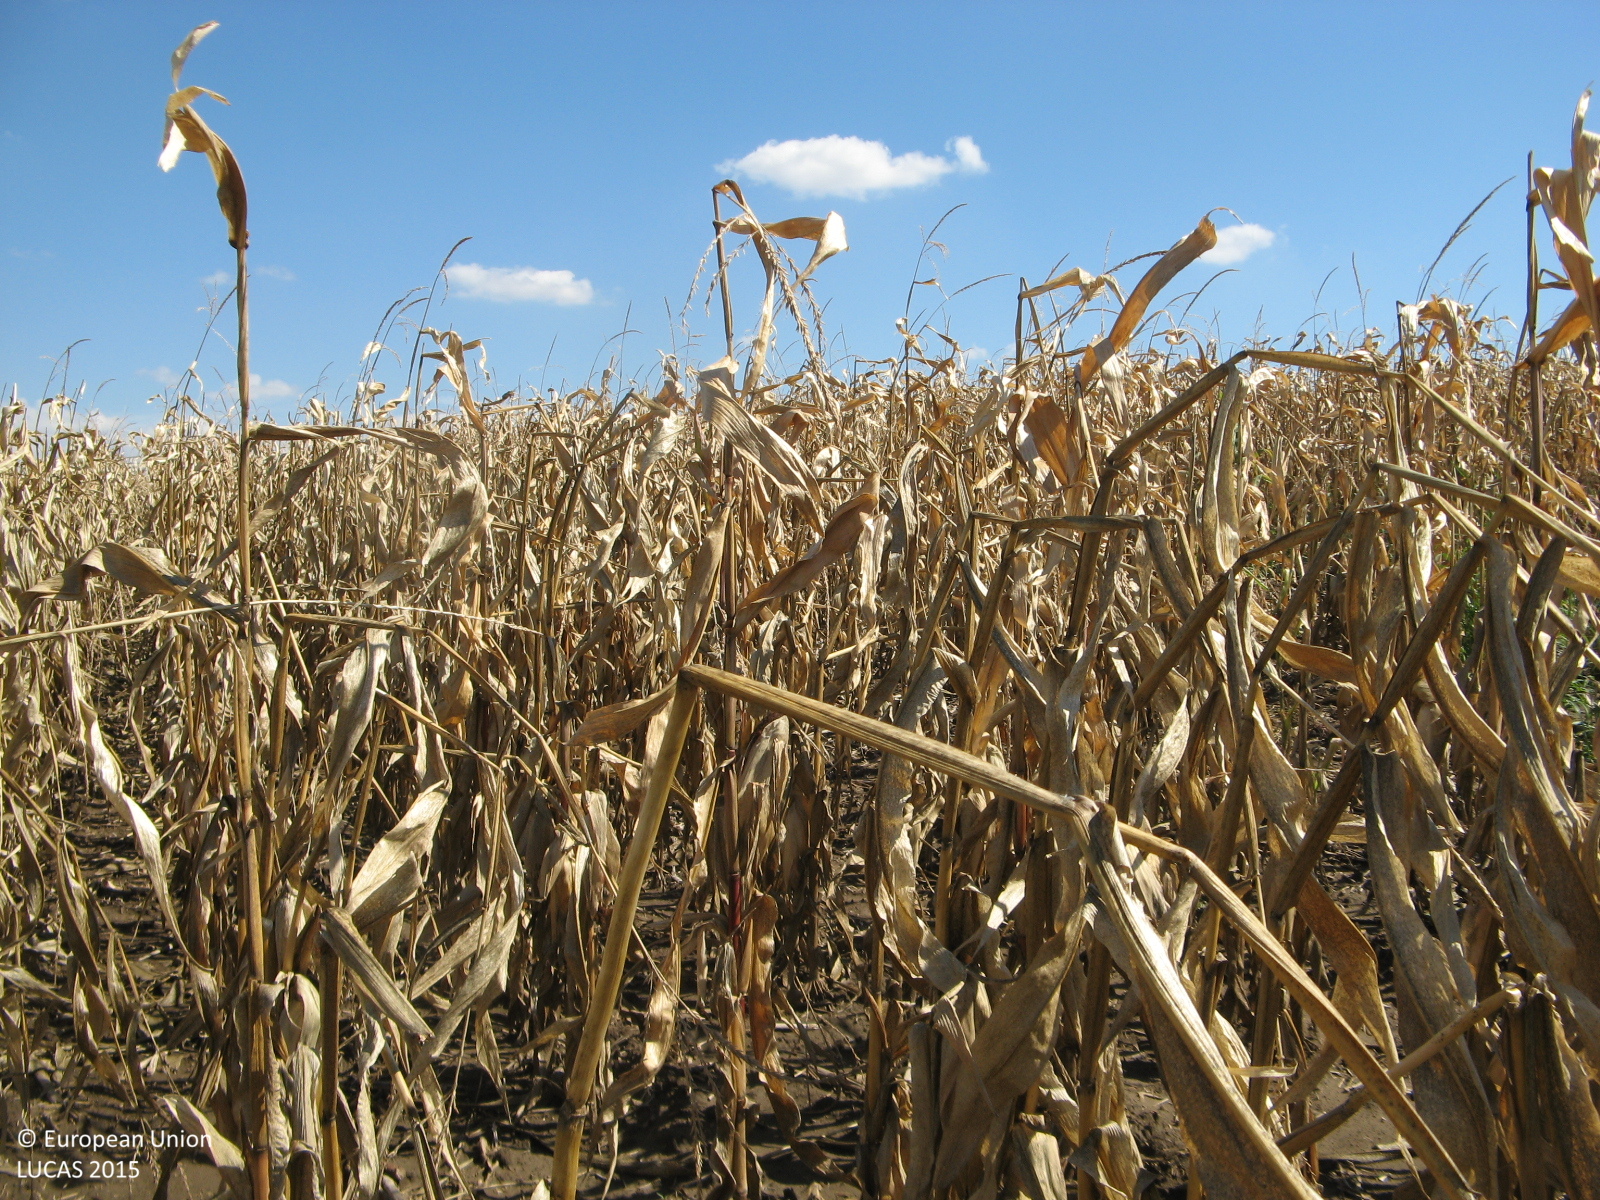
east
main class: Cropland
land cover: Maize
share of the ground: > 75 %
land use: Agriculture (excluding fallow land and kitchen gardens)
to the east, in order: Maize
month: September
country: BG
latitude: 43.5252
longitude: 25.3843
